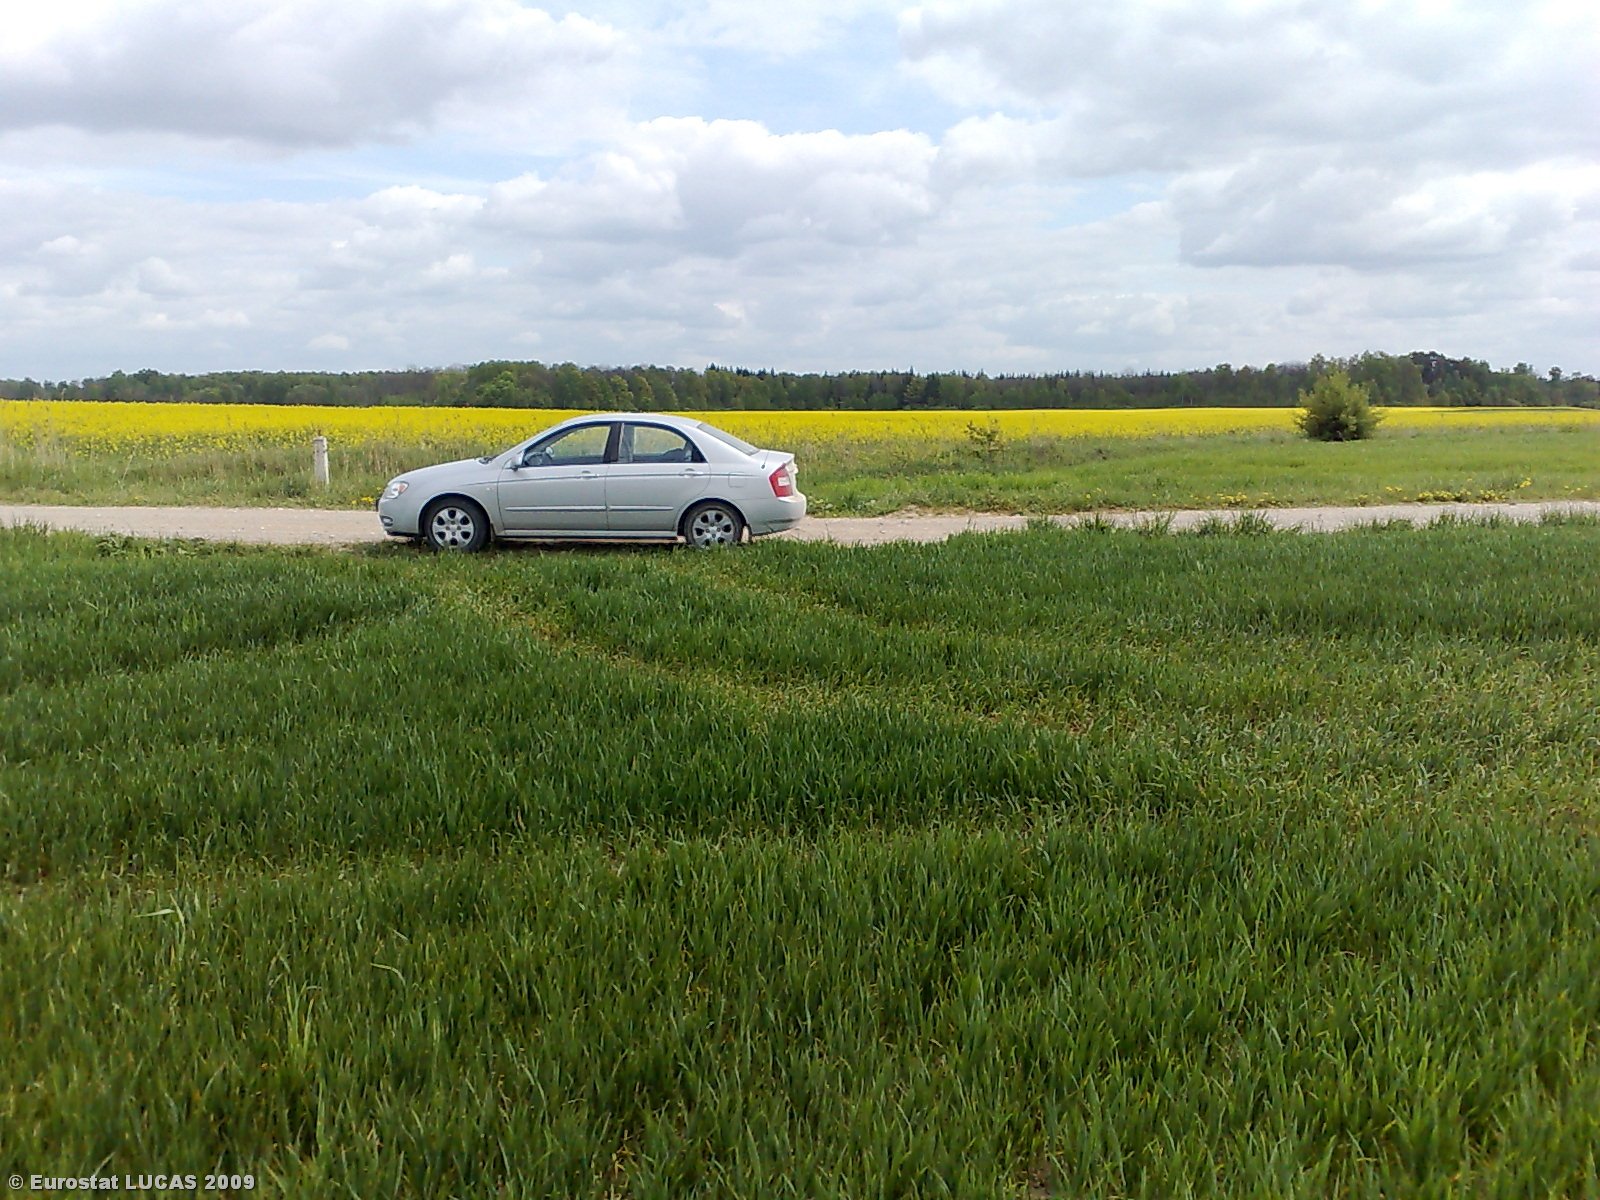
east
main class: Cropland
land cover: Common wheat
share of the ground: > 75 %
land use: Agriculture (excluding fallow land and kitchen gardens)
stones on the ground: < 10 %
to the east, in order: Common wheat; Grass margins; Paved roads, cycling and walking lanes; Grass margins; Common wheat; Grass margins; Ditches and canals; Grass margins; Rape and turnip rape; Bare land
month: May
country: LT
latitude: 55.6881
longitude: 23.8446
